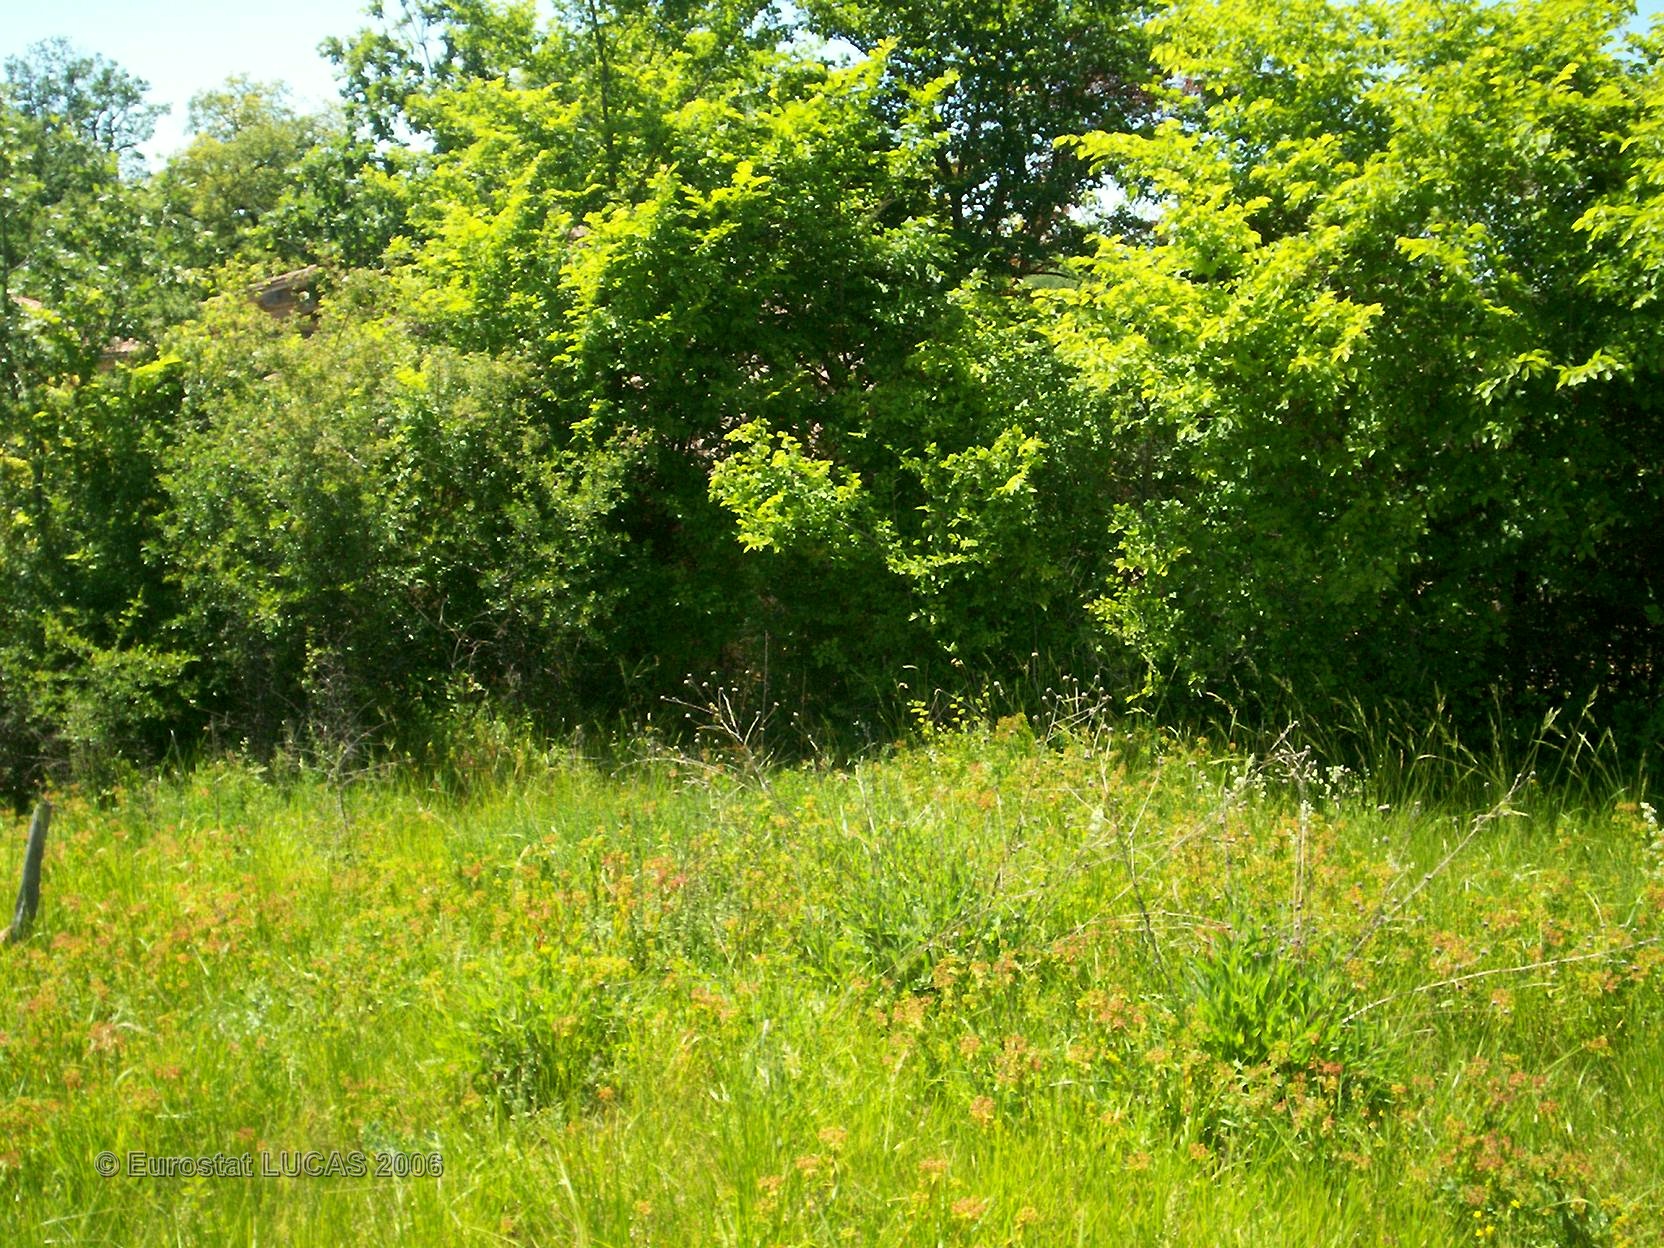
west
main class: Grassland
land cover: Grassland without tree/shrub cover
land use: Agriculture (excluding fallow land and kitchen gardens)
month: June
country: FR
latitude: 43.7793
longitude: 0.8163
